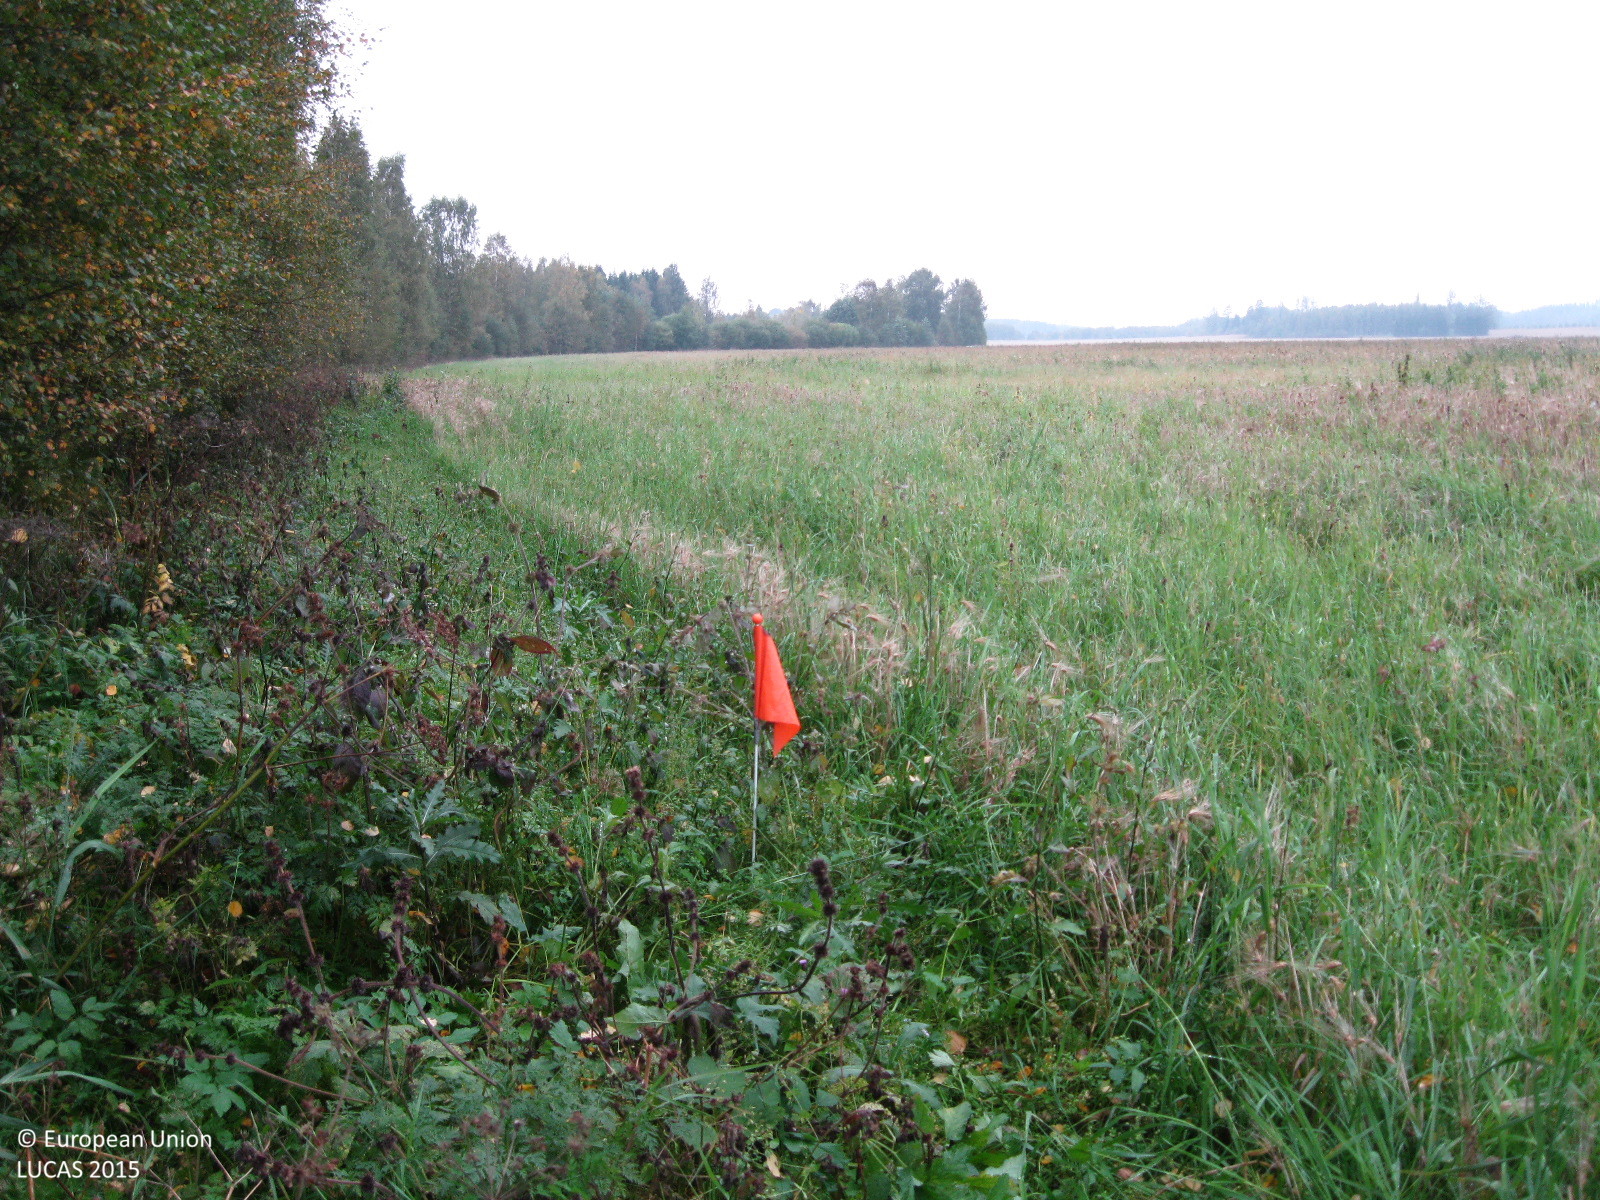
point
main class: Cropland
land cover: Barley
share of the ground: 50 - 75 %
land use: Agriculture (excluding fallow land and kitchen gardens)
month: September
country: FI
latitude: 60.8660
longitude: 24.5970
